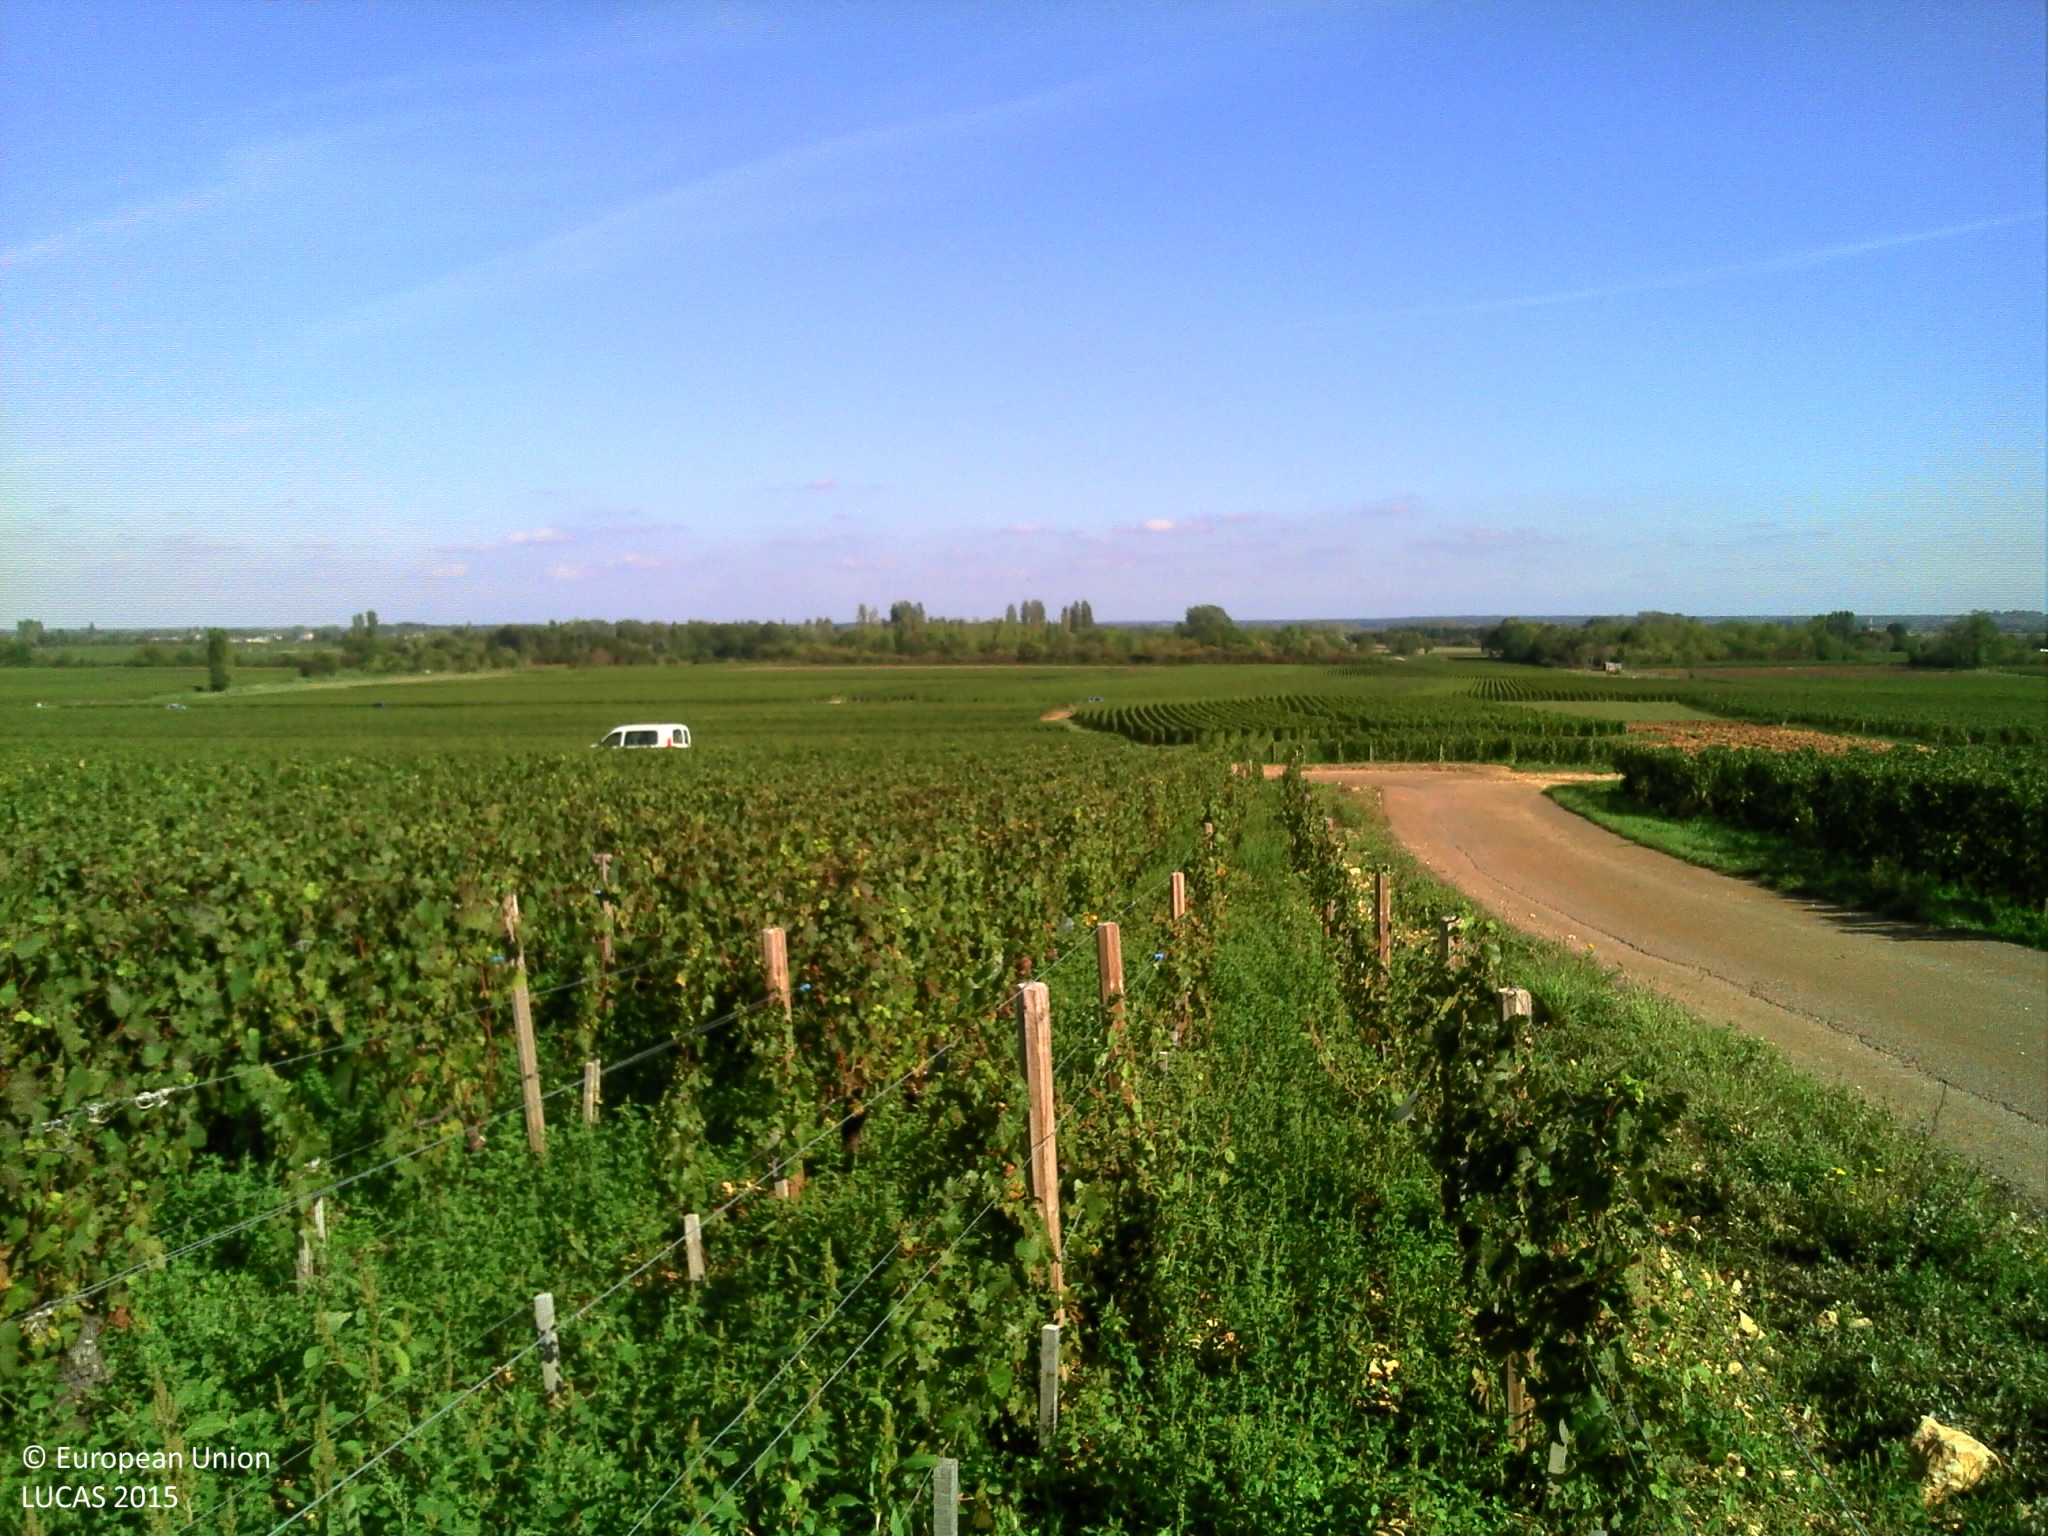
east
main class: Cropland
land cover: Vineyards
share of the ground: > 75 %
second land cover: Spontaneously vegetated surfaces
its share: > 75 %
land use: Agriculture (excluding fallow land and kitchen gardens)
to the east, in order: Vineyards; Spontaneously vegetated surfaces; Grass margins; Paved roads, cycling and walking lanes; Spontaneously vegetated surfaces; Vineyards
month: September
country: FR
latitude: 46.9625
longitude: 4.7571
